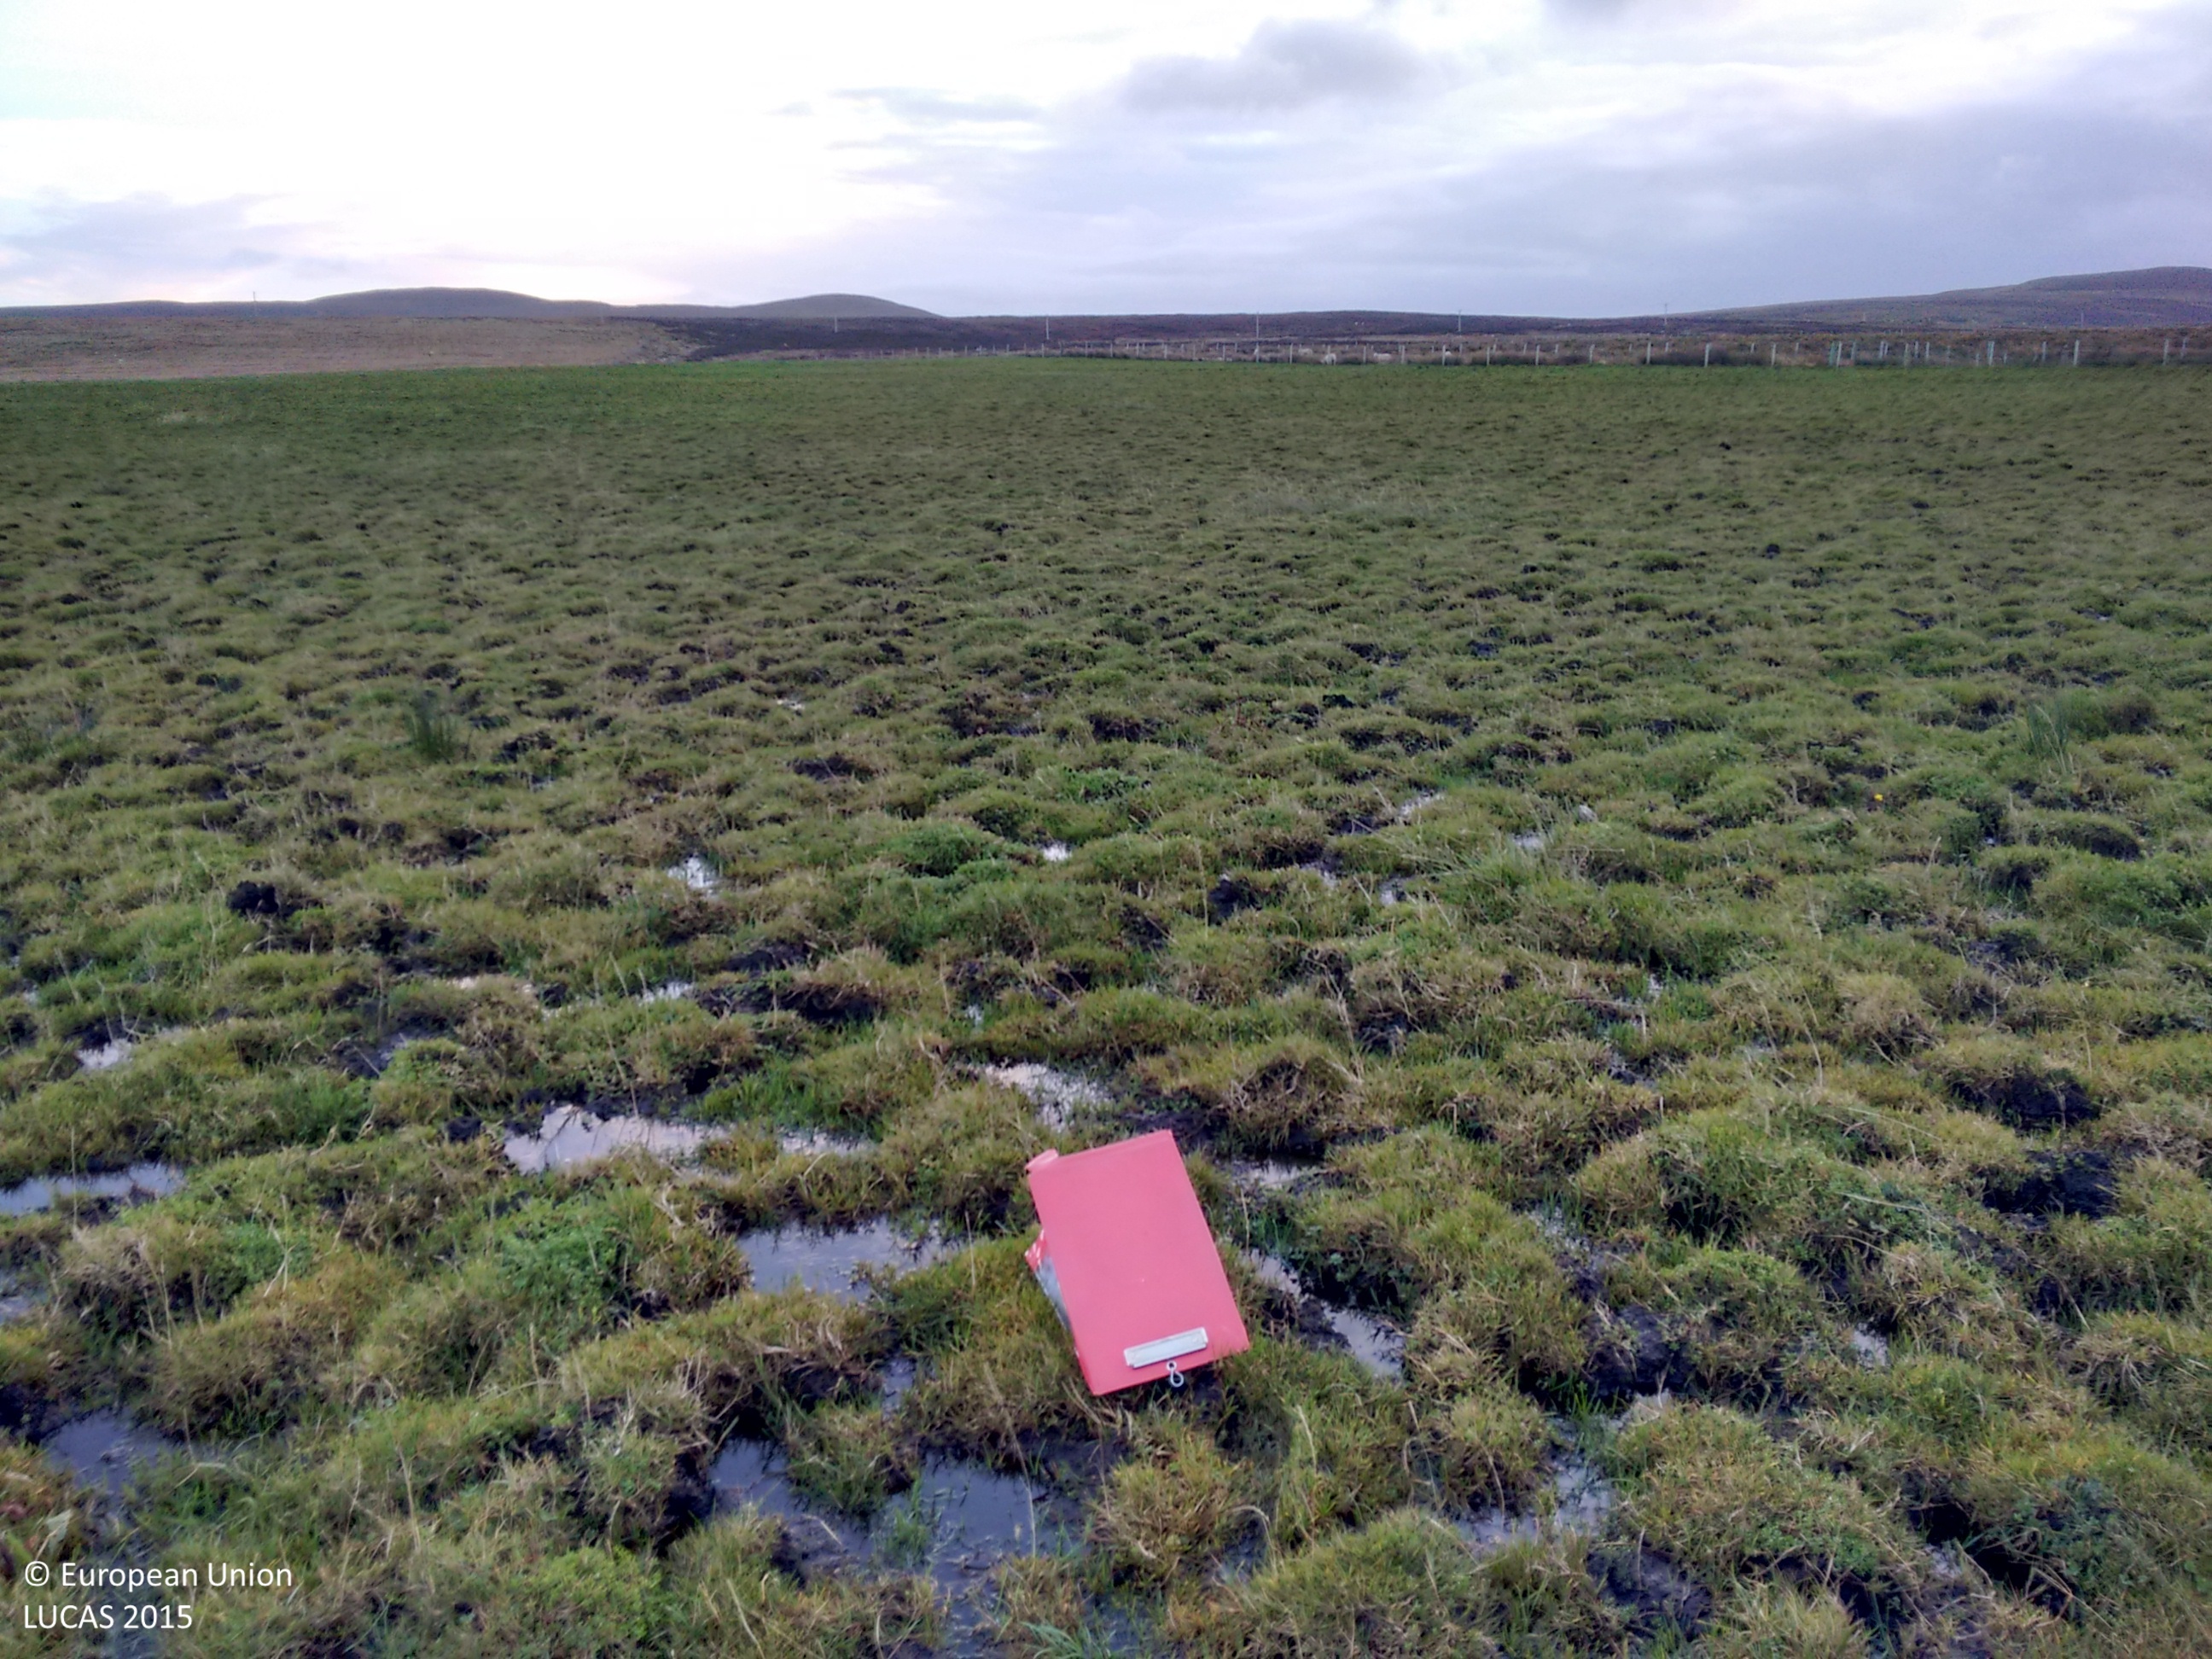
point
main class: Grassland
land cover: Grassland without tree/shrub cover
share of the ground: > 75 %
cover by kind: herbaceous plants 70 %, unconsolidated bare surface 30 %
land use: Agriculture (excluding fallow land and kitchen gardens)
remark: Temporary flooded
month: November
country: GB
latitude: 58.9518
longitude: -3.2155
